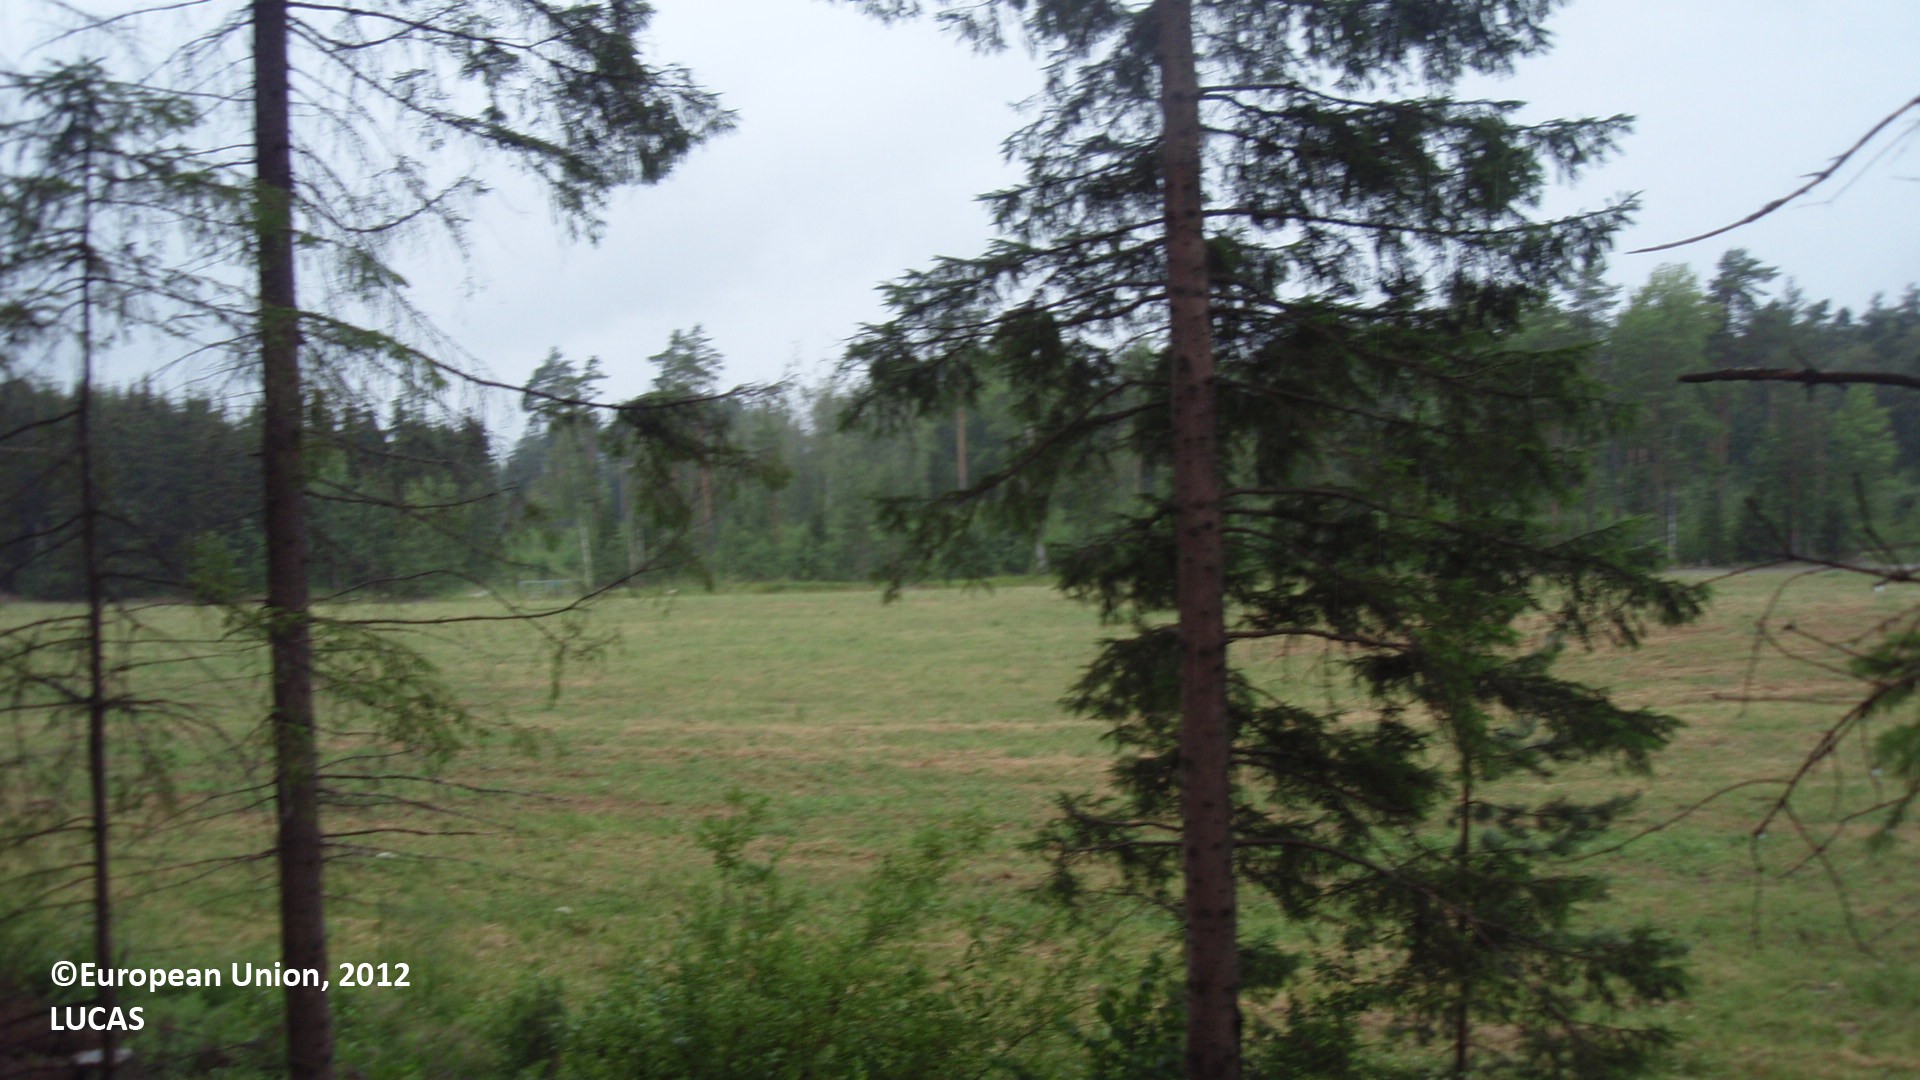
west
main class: Woodland
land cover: Pine dominated mixed woodland
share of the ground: 25 - 50 %
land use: Forestry
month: July
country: FI
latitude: 61.1207
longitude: 28.7297
